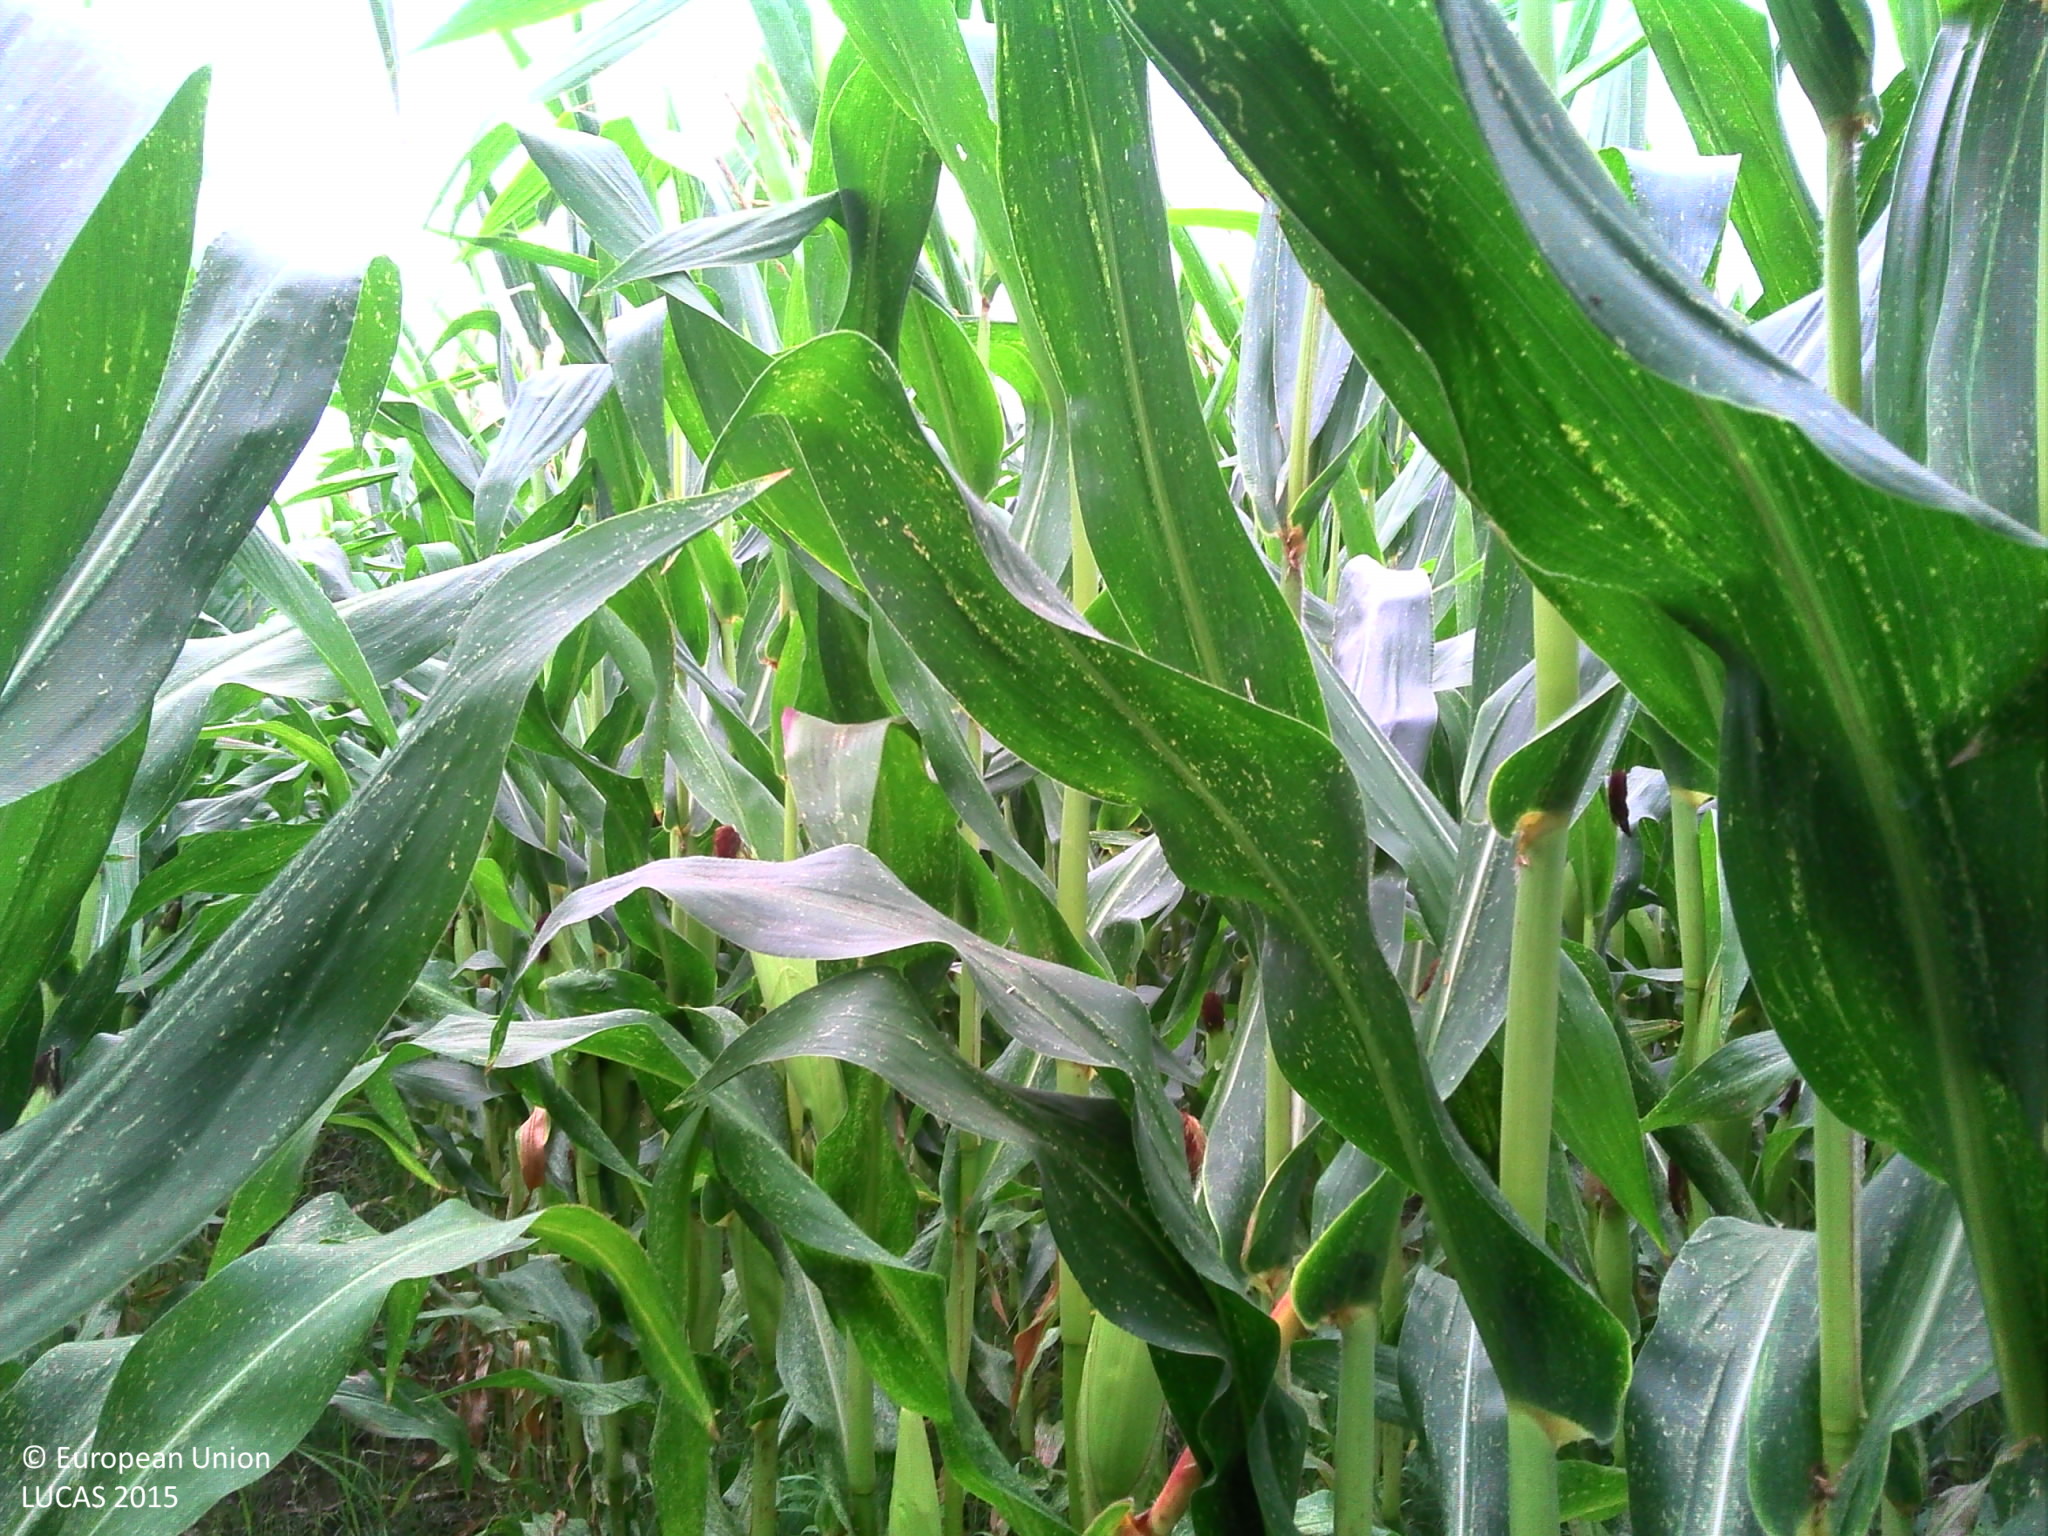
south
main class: Cropland
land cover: Maize
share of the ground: > 75 %
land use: Agriculture (excluding fallow land and kitchen gardens)
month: July
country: FR
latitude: 44.3985
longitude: 0.6401
